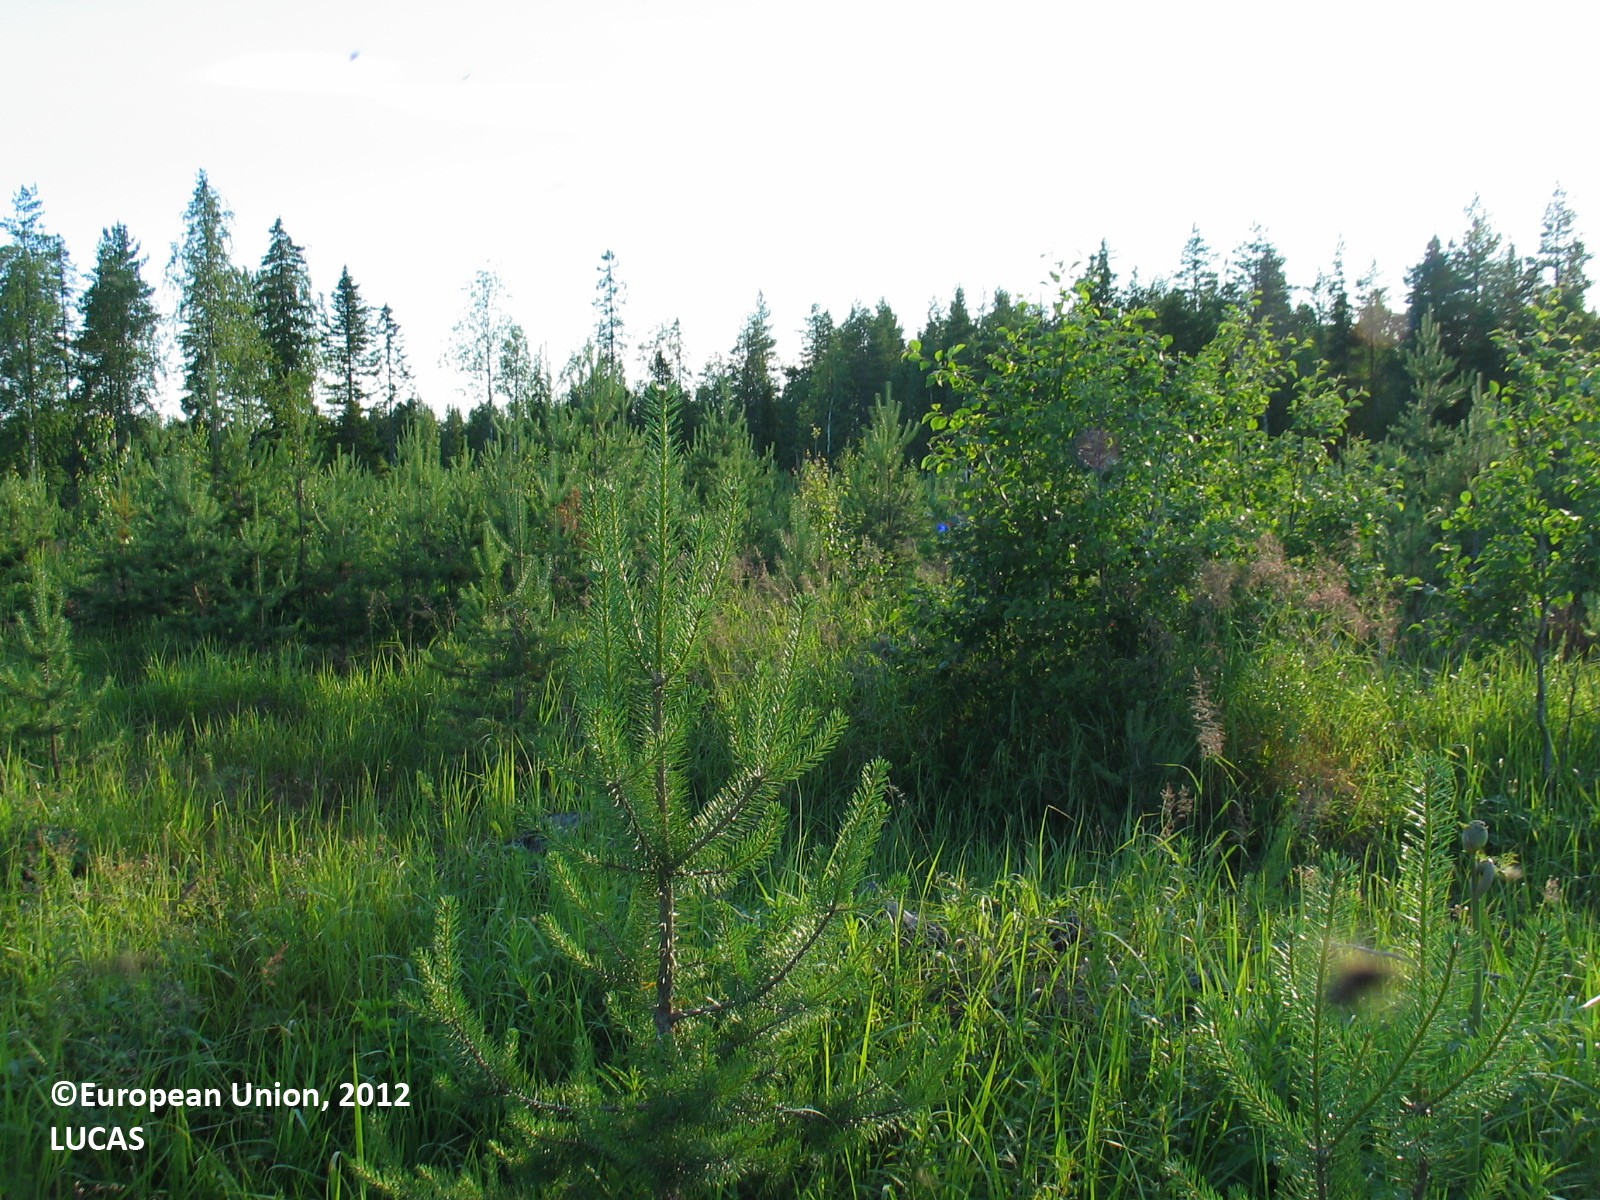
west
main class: Woodland
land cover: Other mixed woodland
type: boreal forest
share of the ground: 10 - 25 %
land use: Forestry
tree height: < 5 m
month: July
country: FI
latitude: 65.8647
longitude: 24.9430
